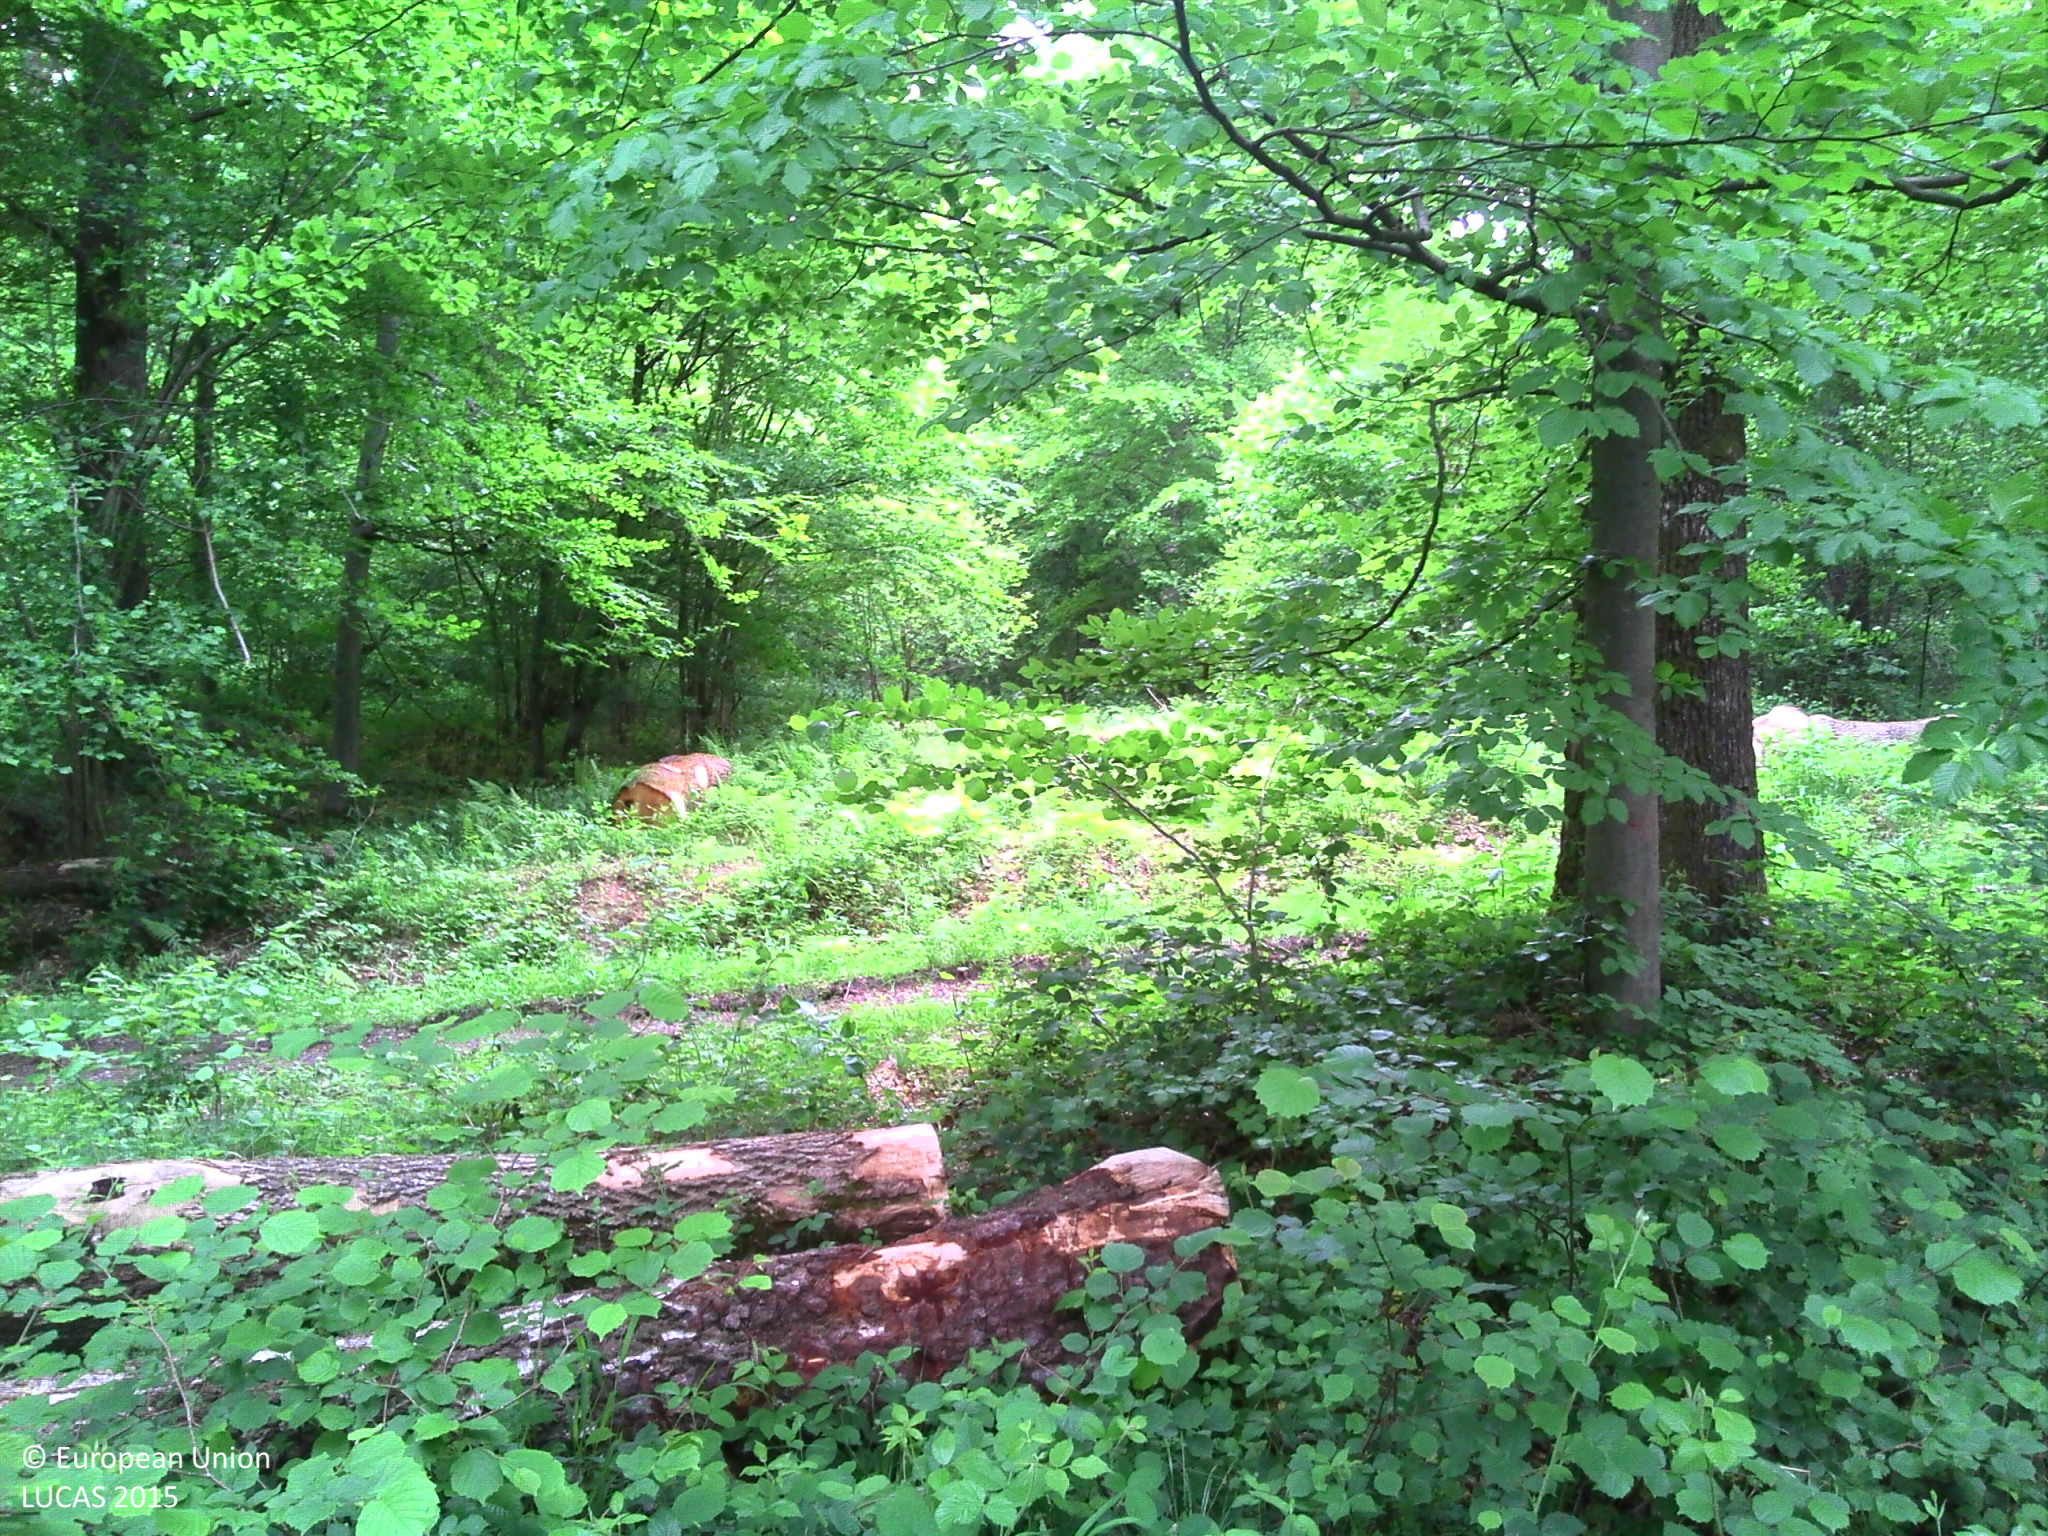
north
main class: Woodland
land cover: Broadleaved woodland
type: acidophilous oak and oak-birch forest
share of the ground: > 75 %
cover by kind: broadleaved forest trees 85 %, herbaceous plants 15 %
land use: Forestry
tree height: > 5 m
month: June
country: BE
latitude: 50.4053
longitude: 5.5944
